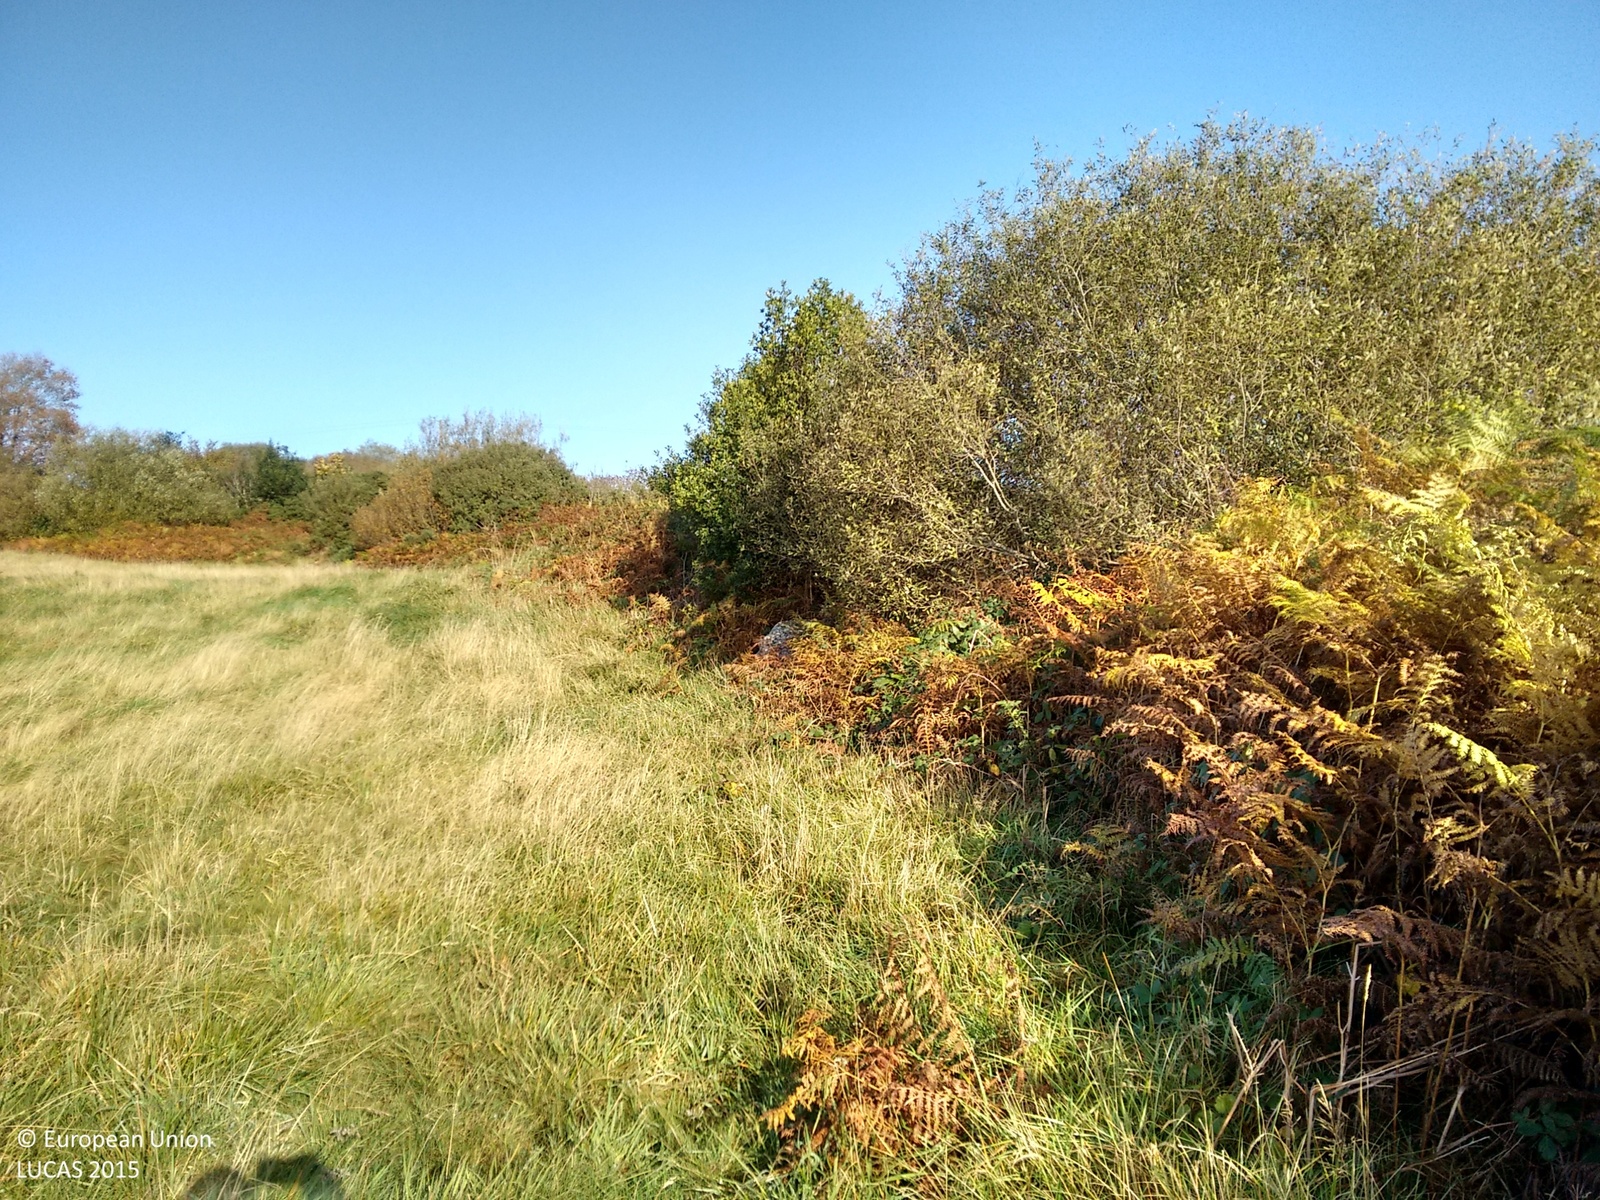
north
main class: Grassland
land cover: Grassland without tree/shrub cover
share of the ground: > 75 %
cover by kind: herbaceous plants 100 %
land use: Agriculture (excluding fallow land and kitchen gardens)
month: October
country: IE
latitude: 53.9821
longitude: -8.3168
